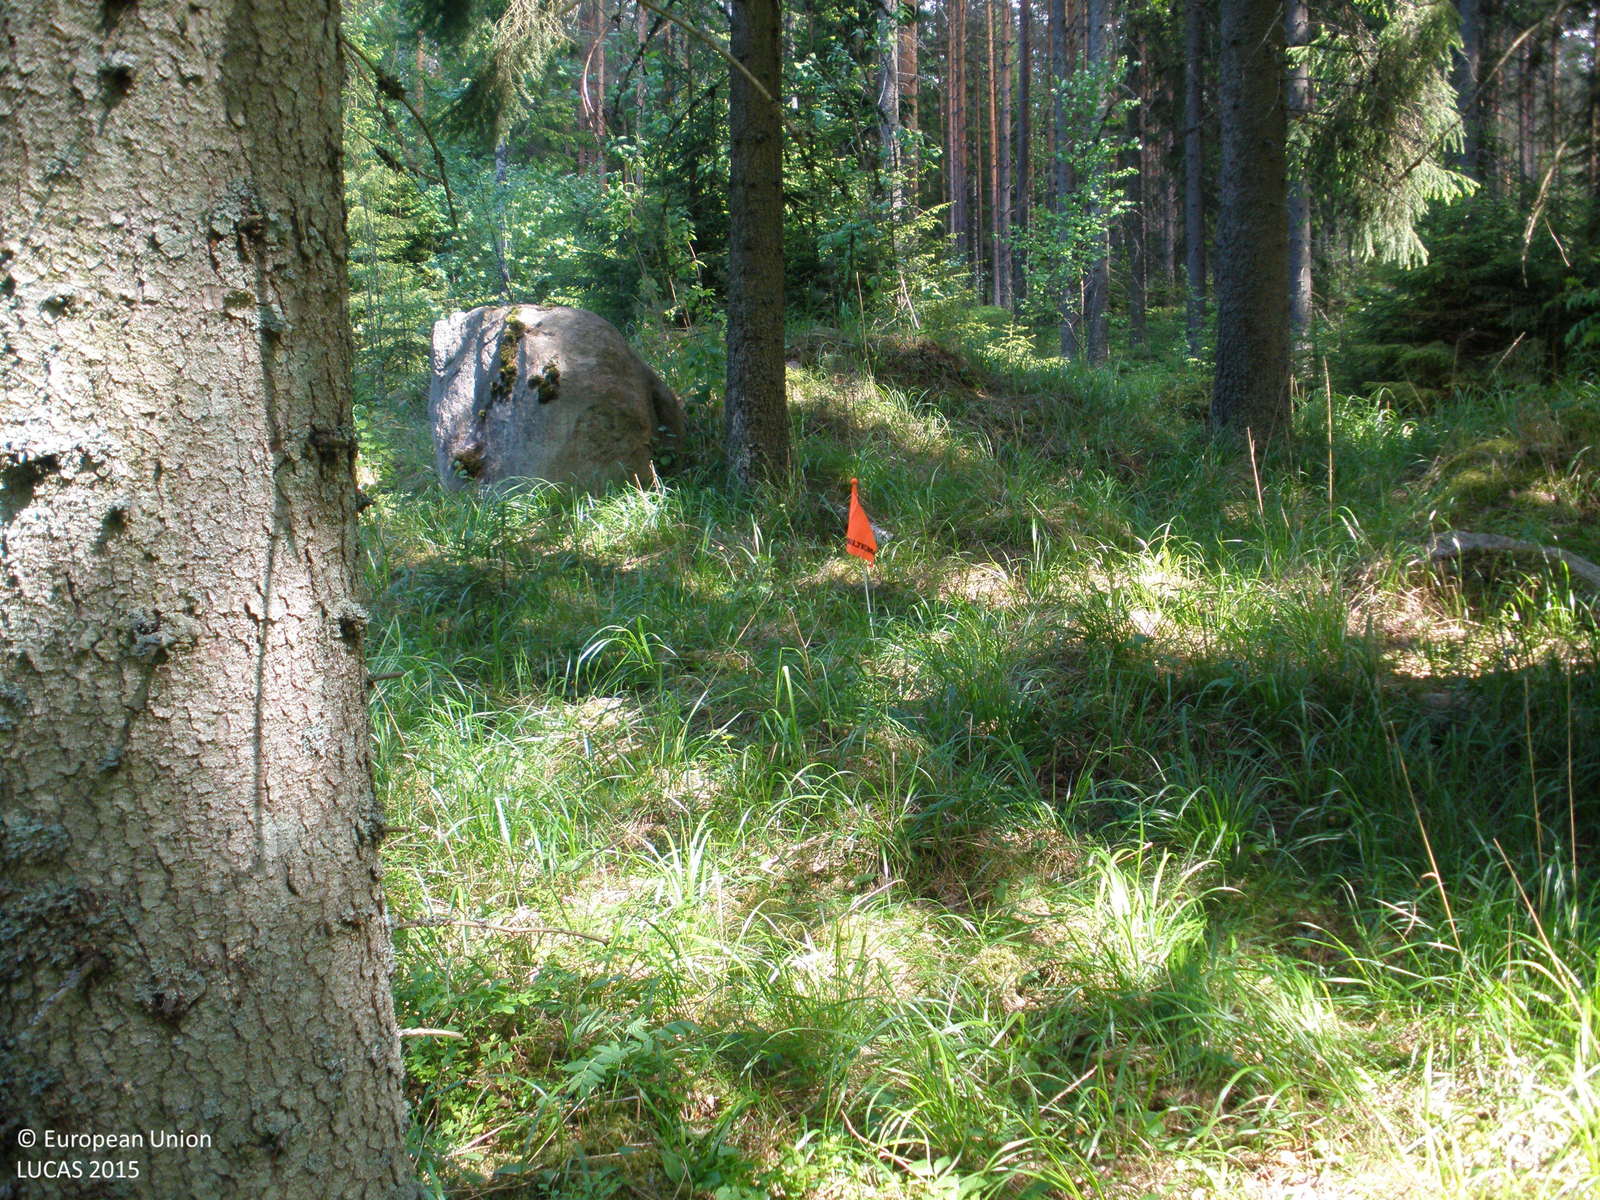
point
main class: Woodland
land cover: Spruce dominated mixed woodland
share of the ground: > 75 %
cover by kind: coniferous forest trees 70 %, broadleaved forest trees 25 %, shrubs 5 %
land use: Forestry
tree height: > 5 m
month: June
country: FI
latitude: 60.5674
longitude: 23.3465
